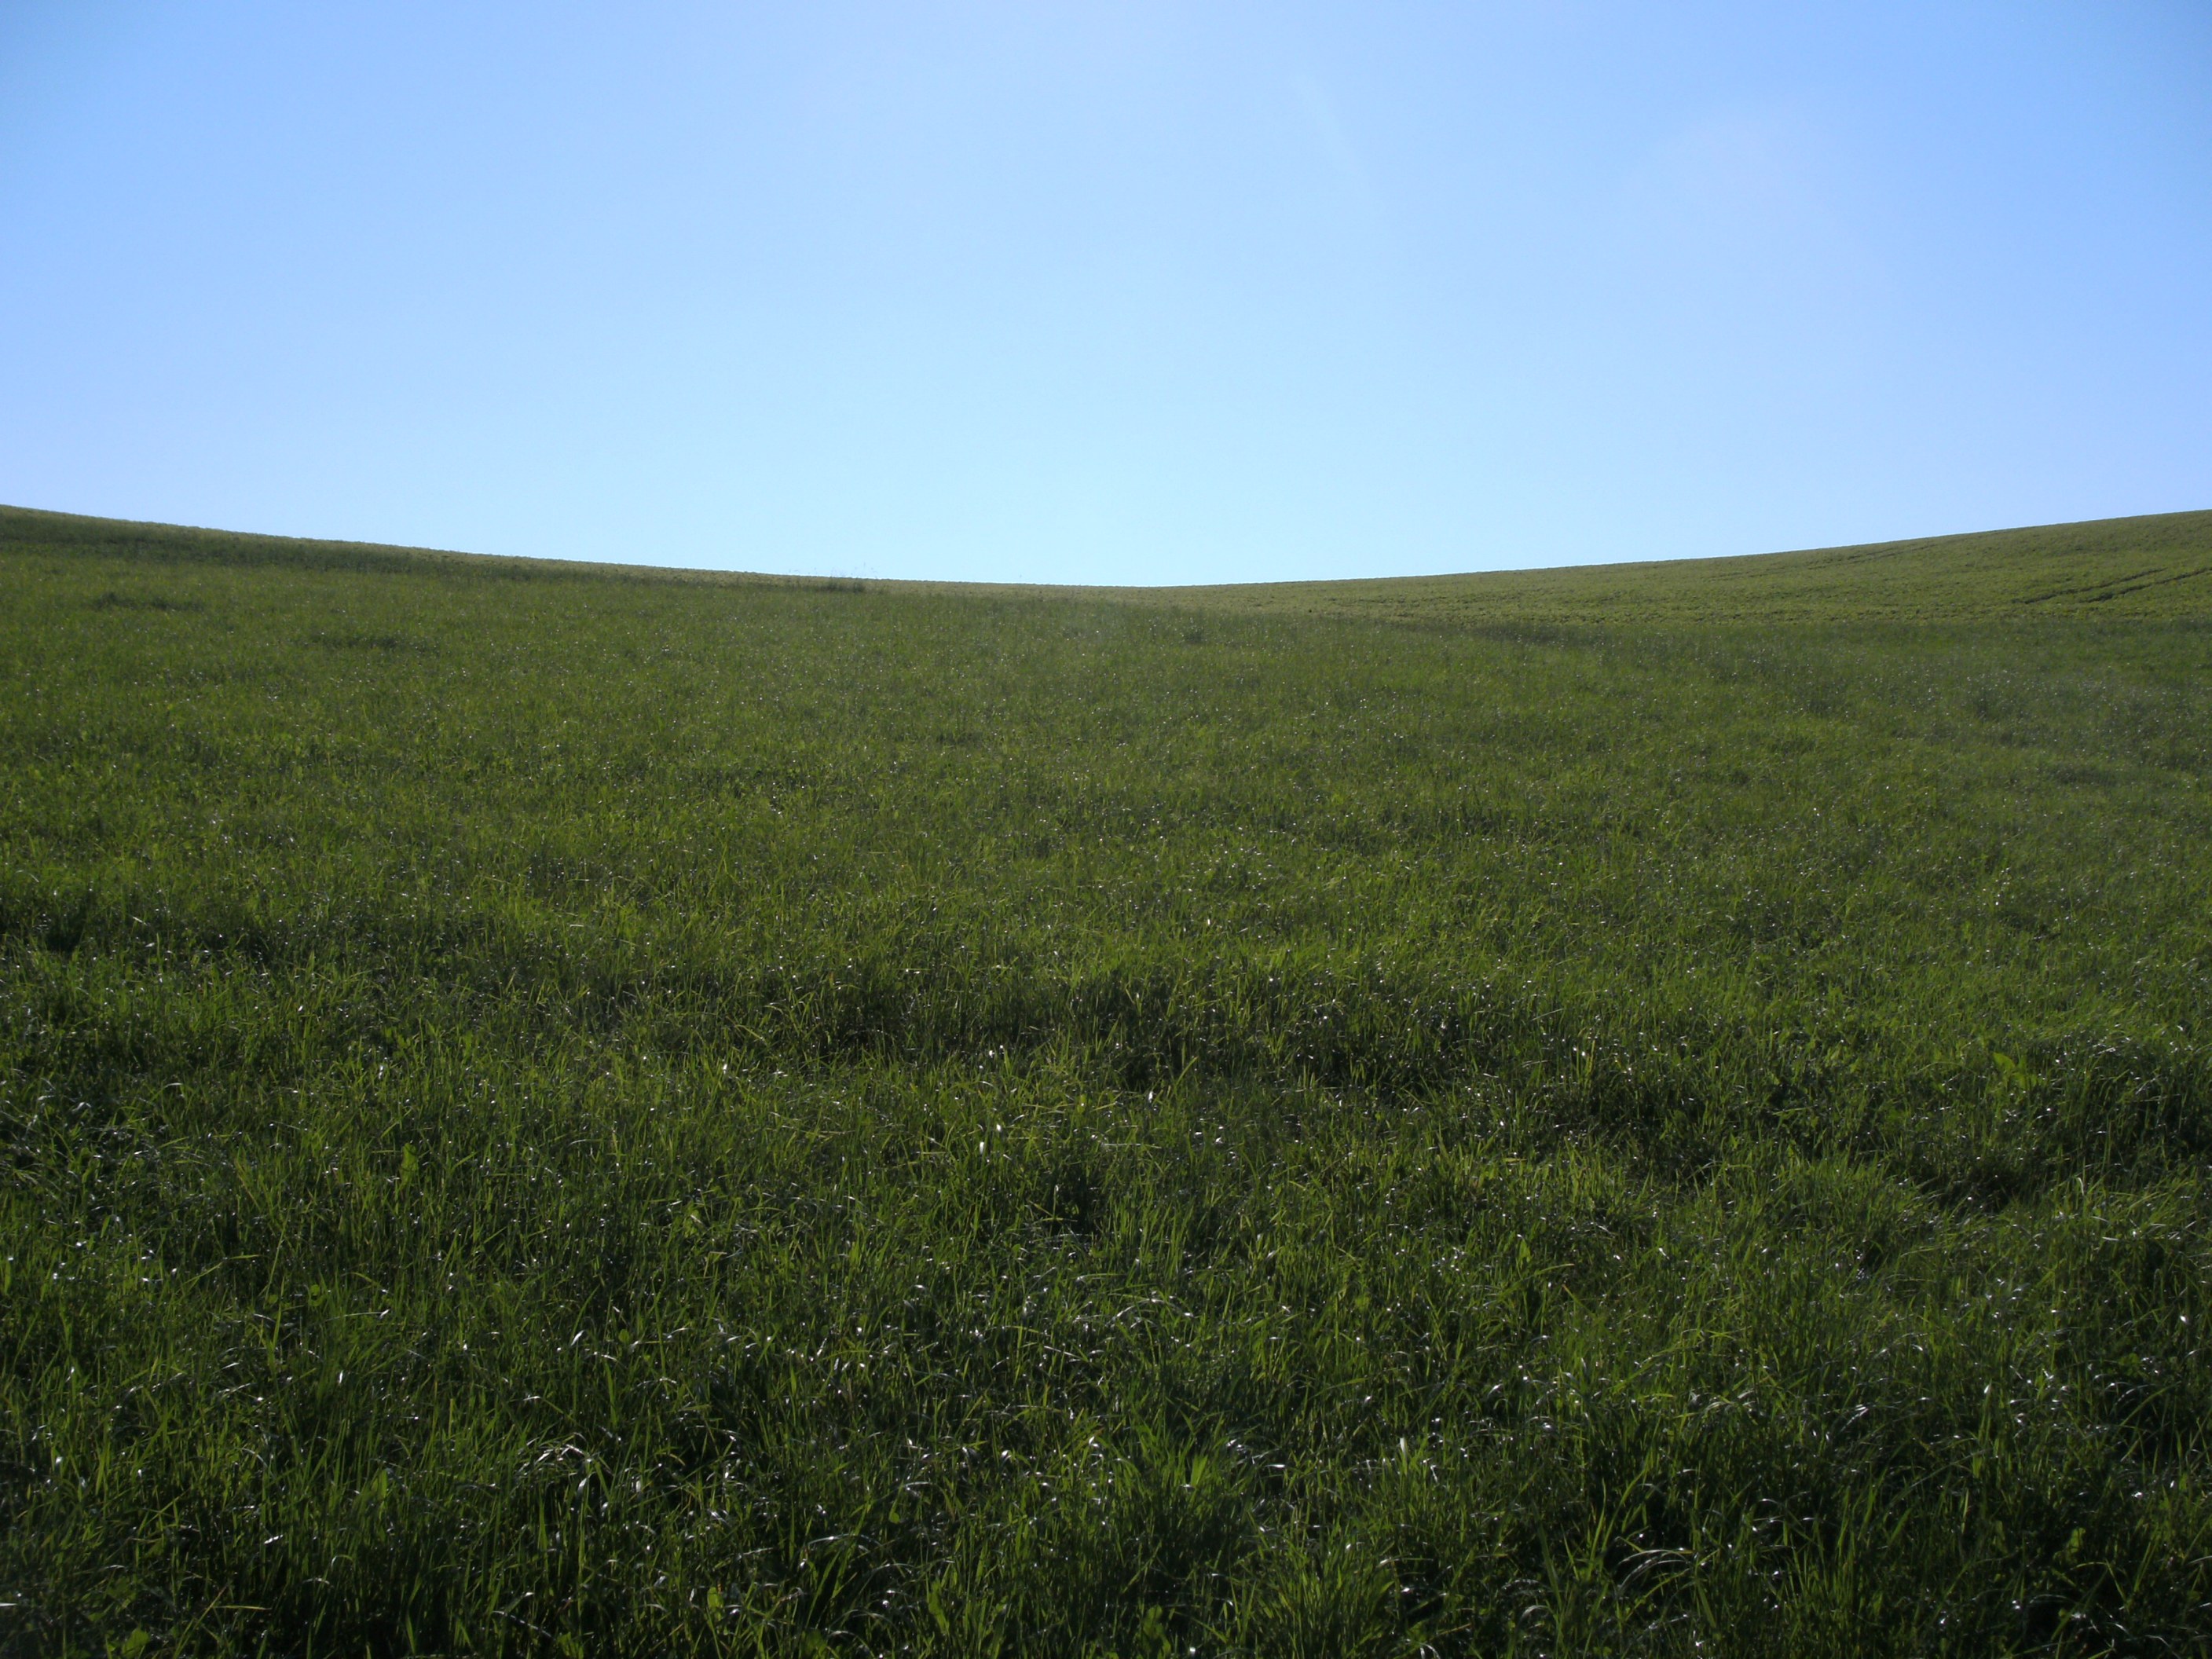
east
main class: Grassland
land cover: Grassland without tree/shrub cover
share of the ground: > 75 %
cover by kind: herbaceous plants 100 %
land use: Agriculture (excluding fallow land and kitchen gardens)
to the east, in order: Grassland without tree/shrub cover; Soya; Shrubland without tree cover; Grassland without tree/shrub cover
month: July
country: AT
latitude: 48.1677
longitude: 13.5087
